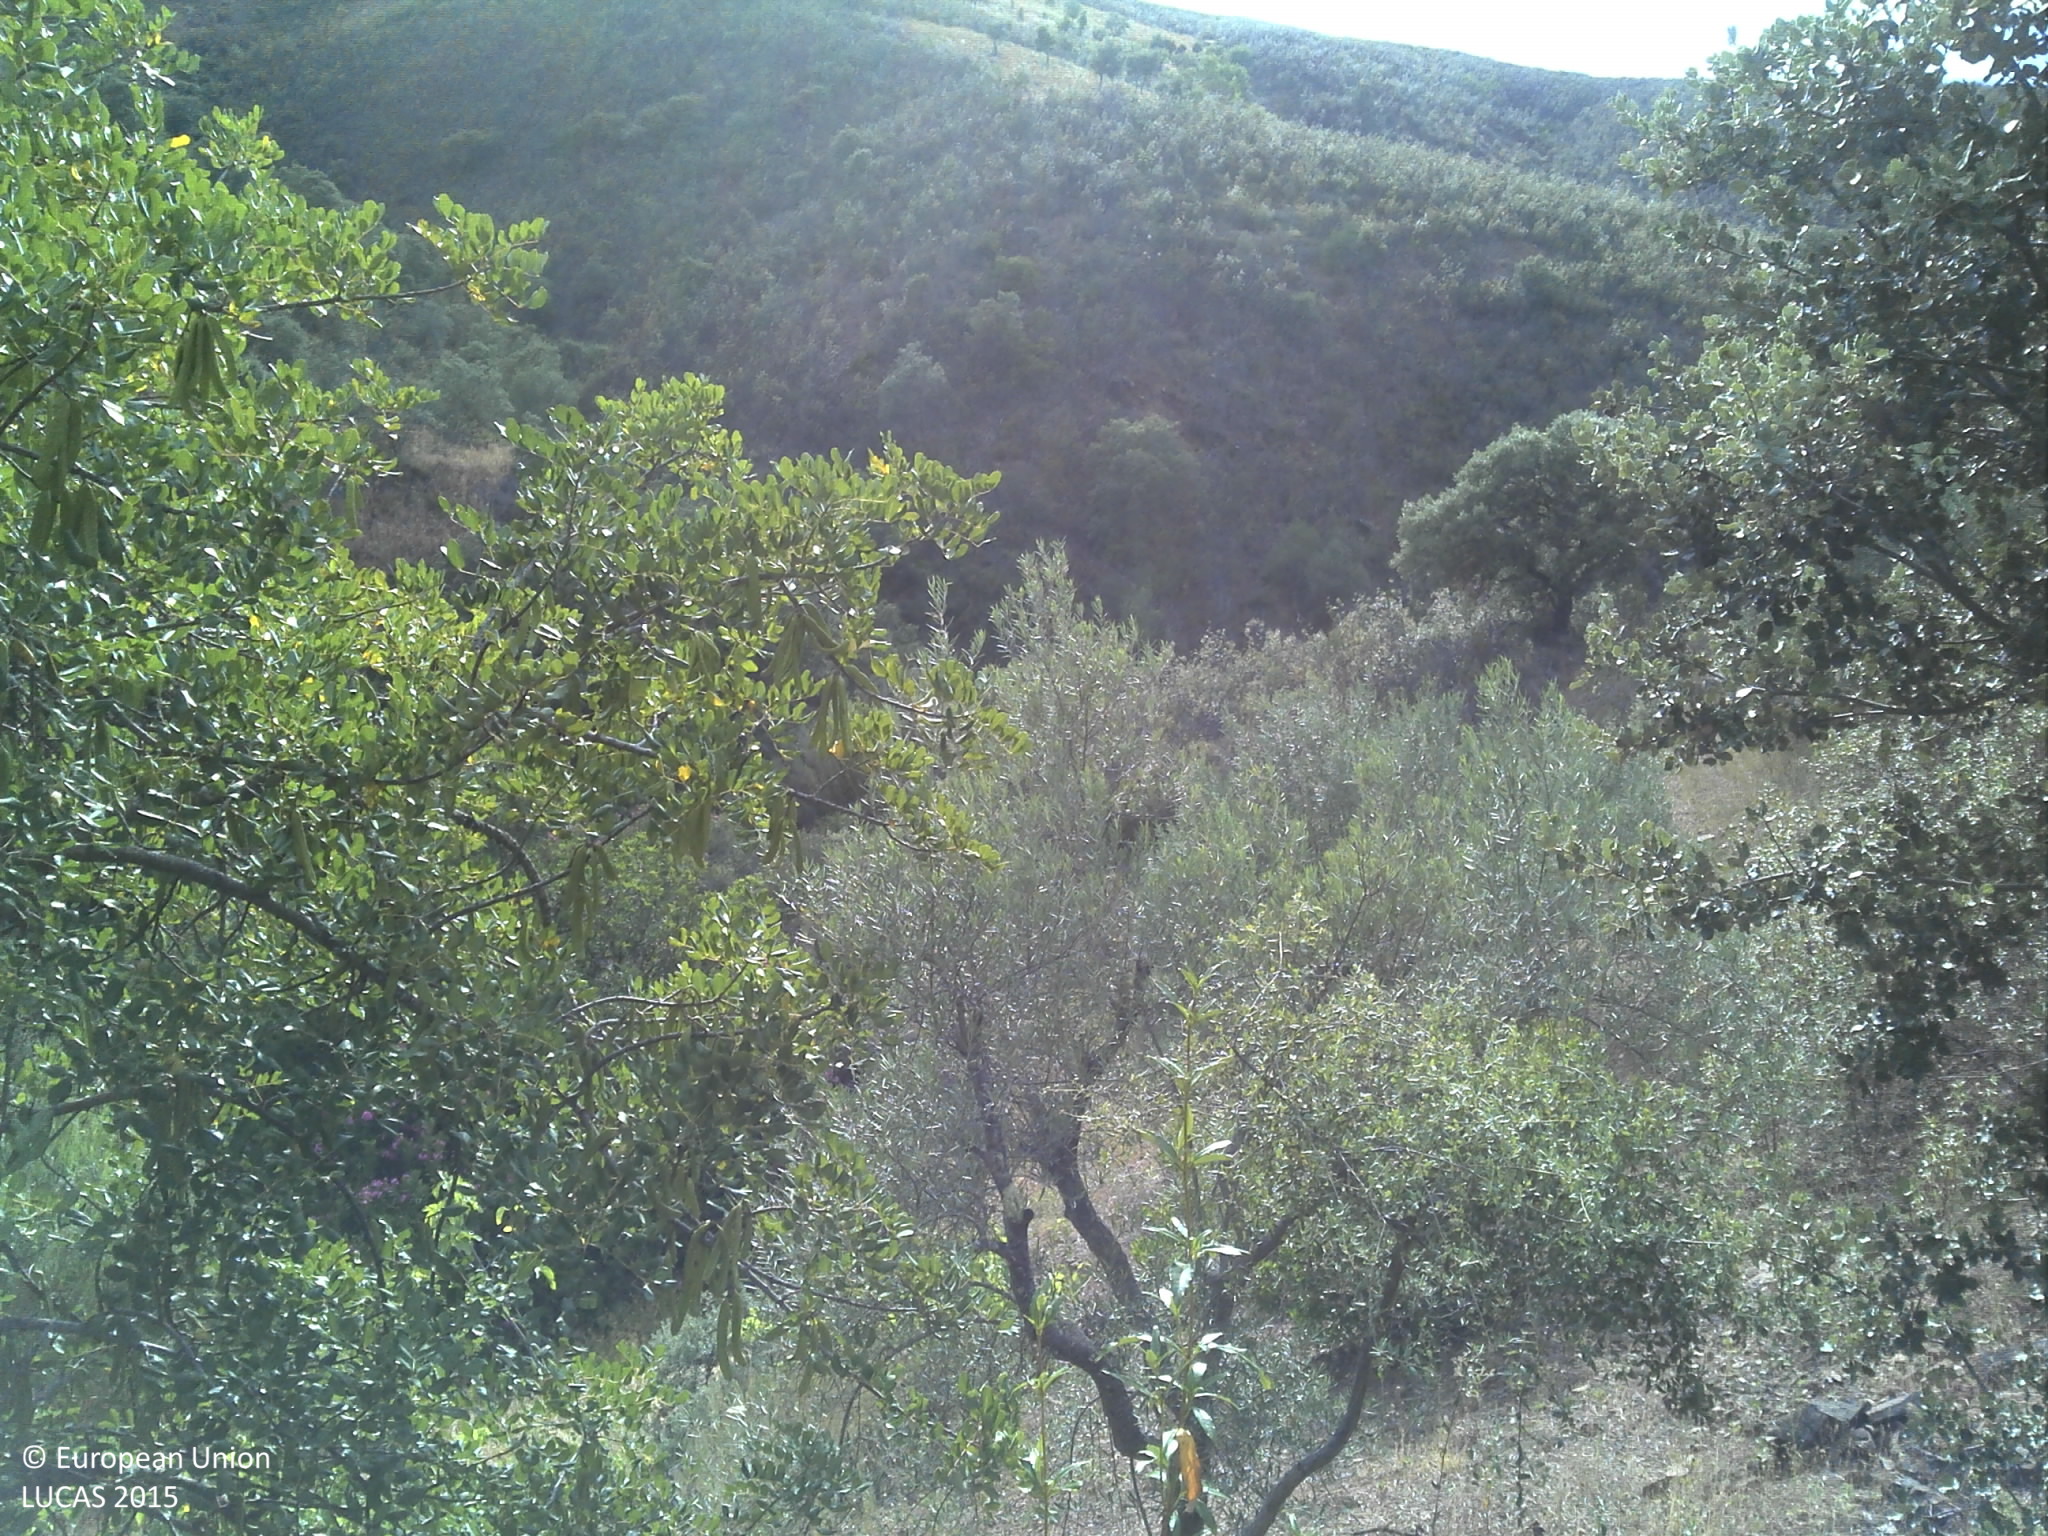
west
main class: Shrubland
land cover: Shrubland without tree cover
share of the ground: > 75 %
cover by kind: shrubs 100 %
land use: Abandoned areas
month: June
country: PT
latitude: 37.2749
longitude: -7.7038
